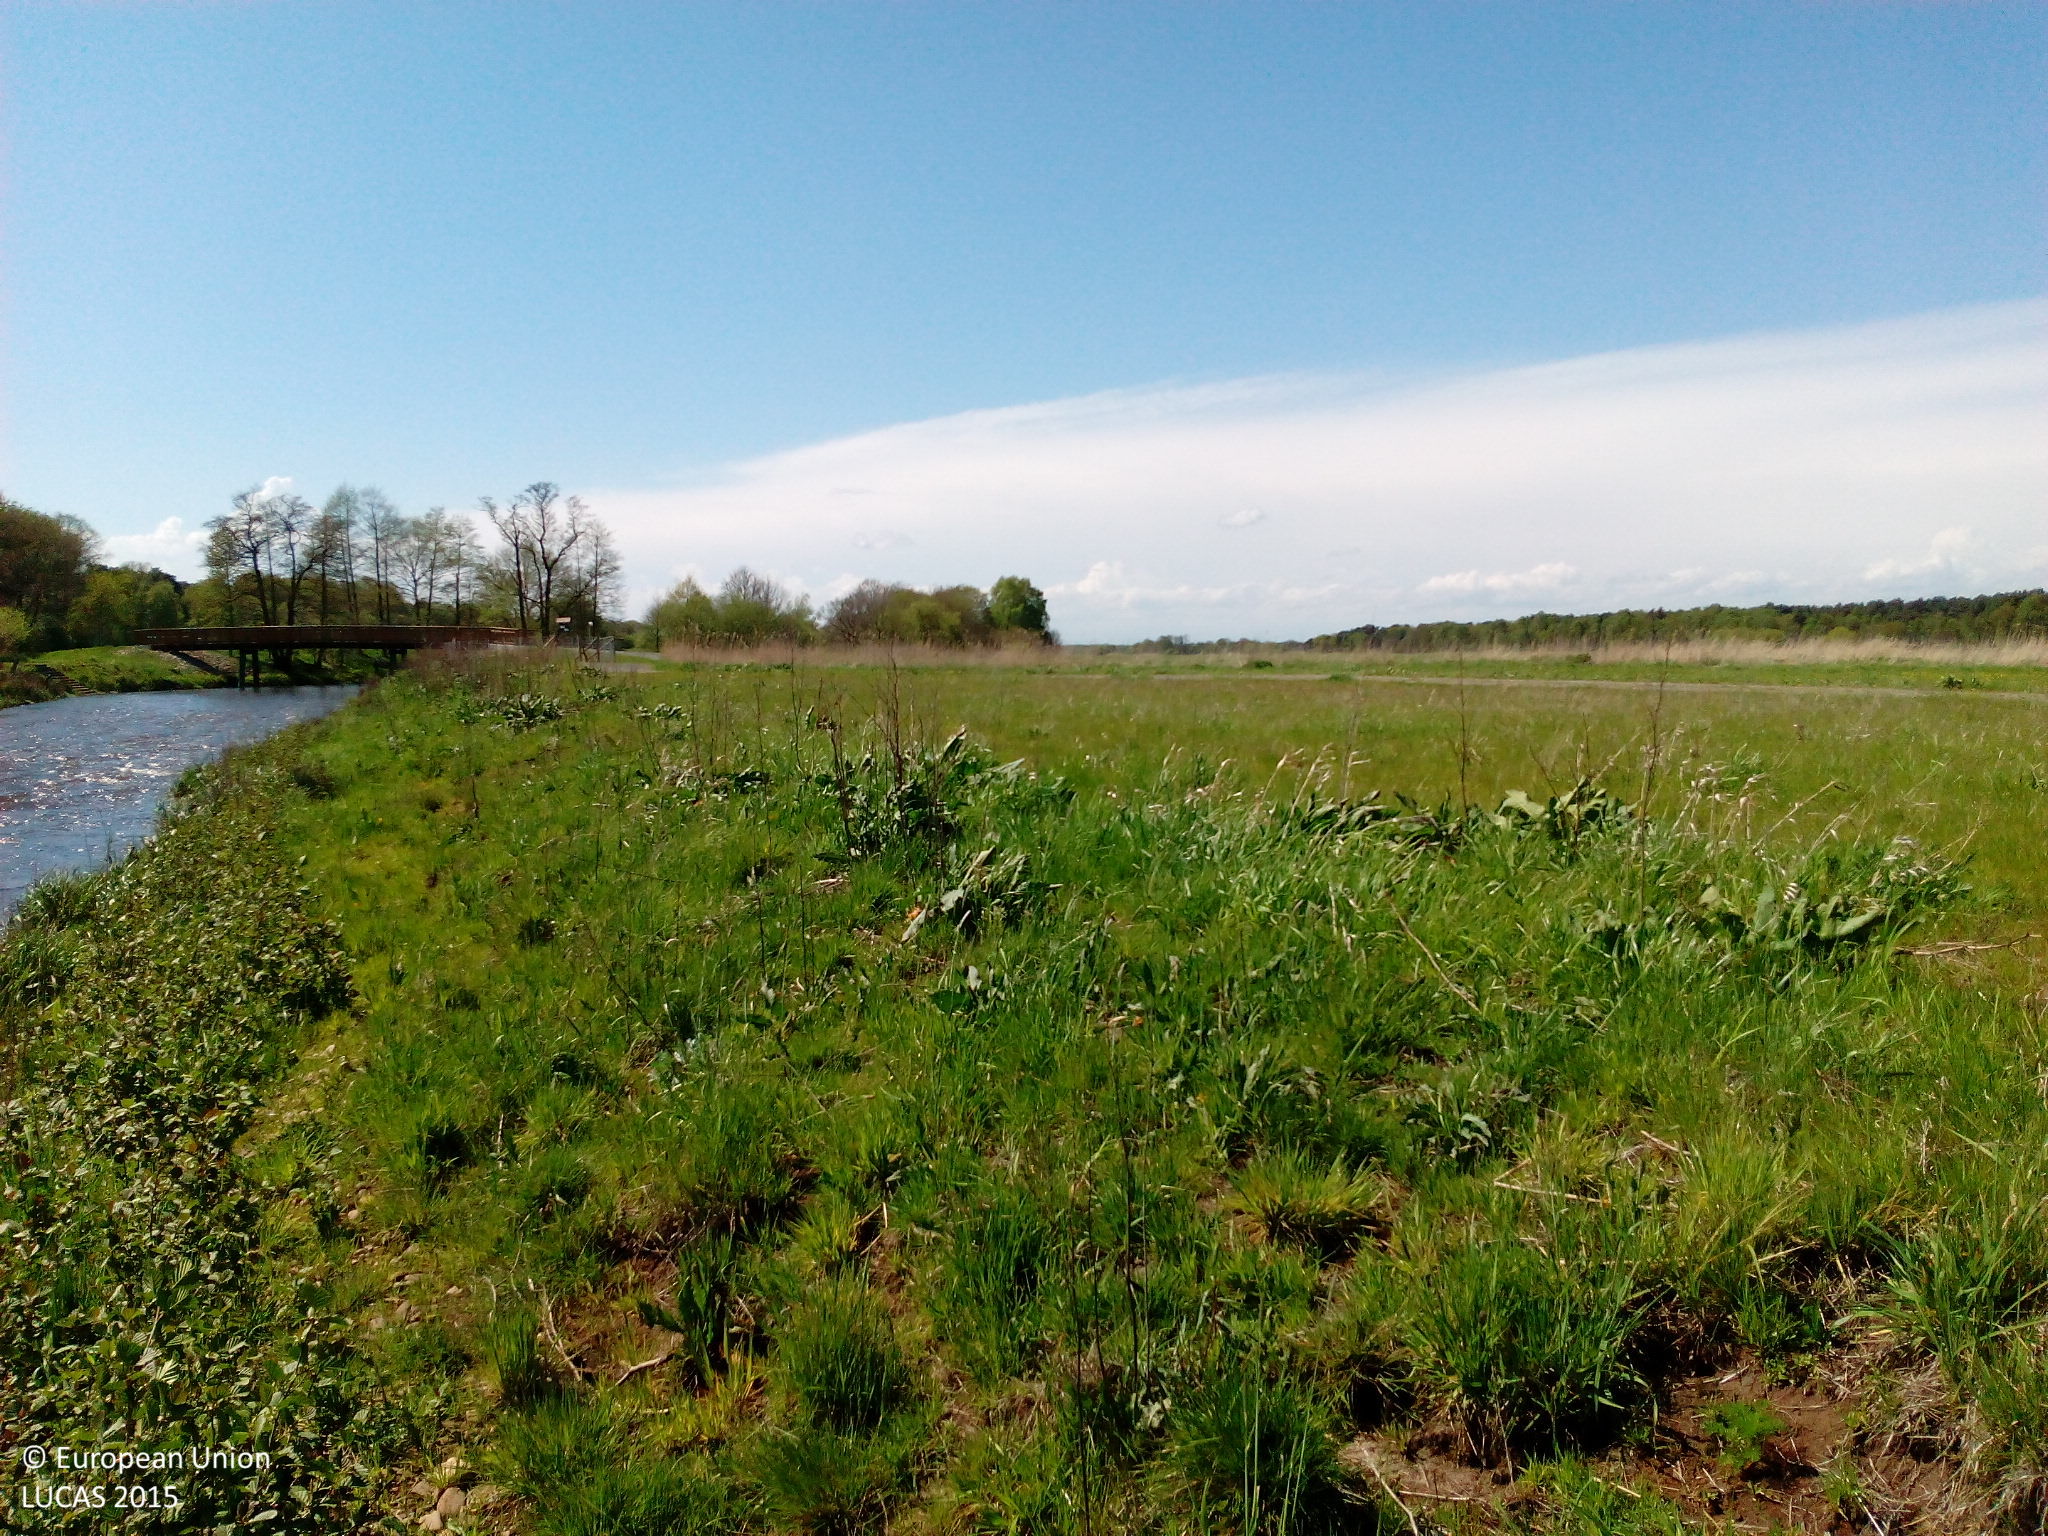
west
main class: Grassland
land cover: Spontaneously vegetated surfaces
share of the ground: > 75 %
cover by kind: herbaceous plants 100 %
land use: Semi-natural and natural areas not in use
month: May
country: DE
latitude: 53.0758
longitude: 9.2092
